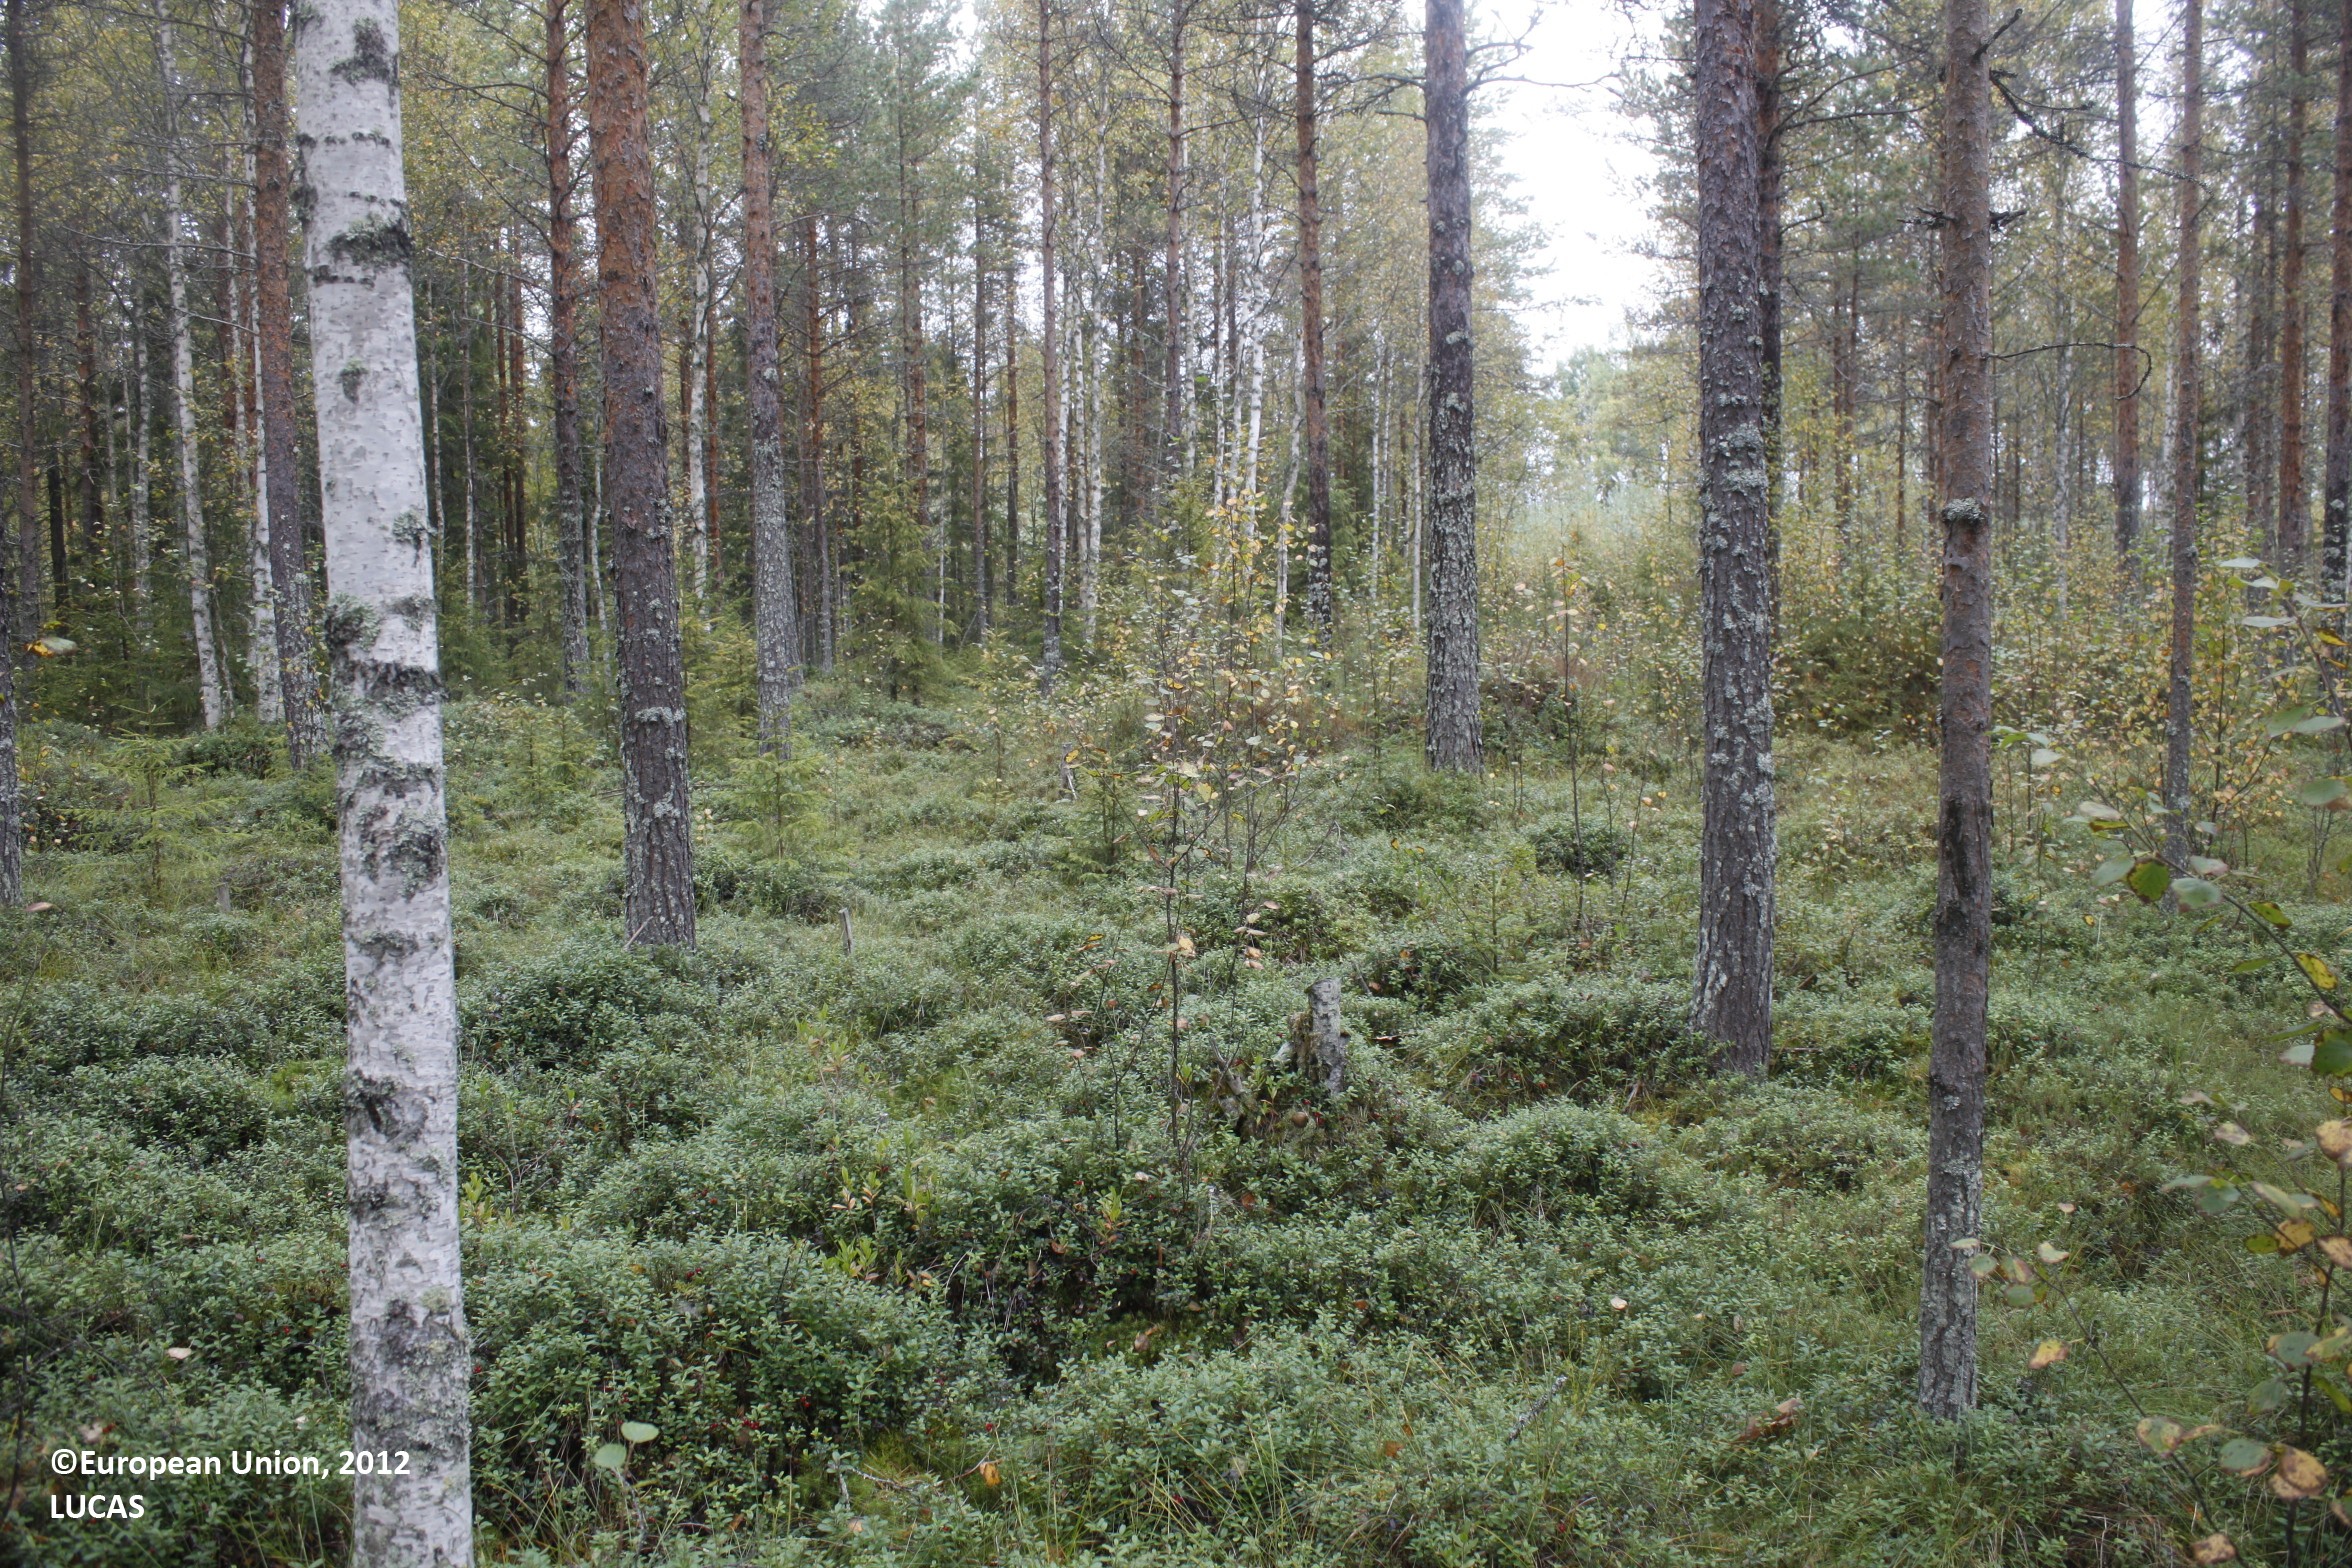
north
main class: Woodland
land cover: Pine dominated coniferous woodland
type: boreal forest
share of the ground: 50 - 75 %
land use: Forestry
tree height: > 5 m
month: September
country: FI
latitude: 65.1050
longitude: 26.6532
